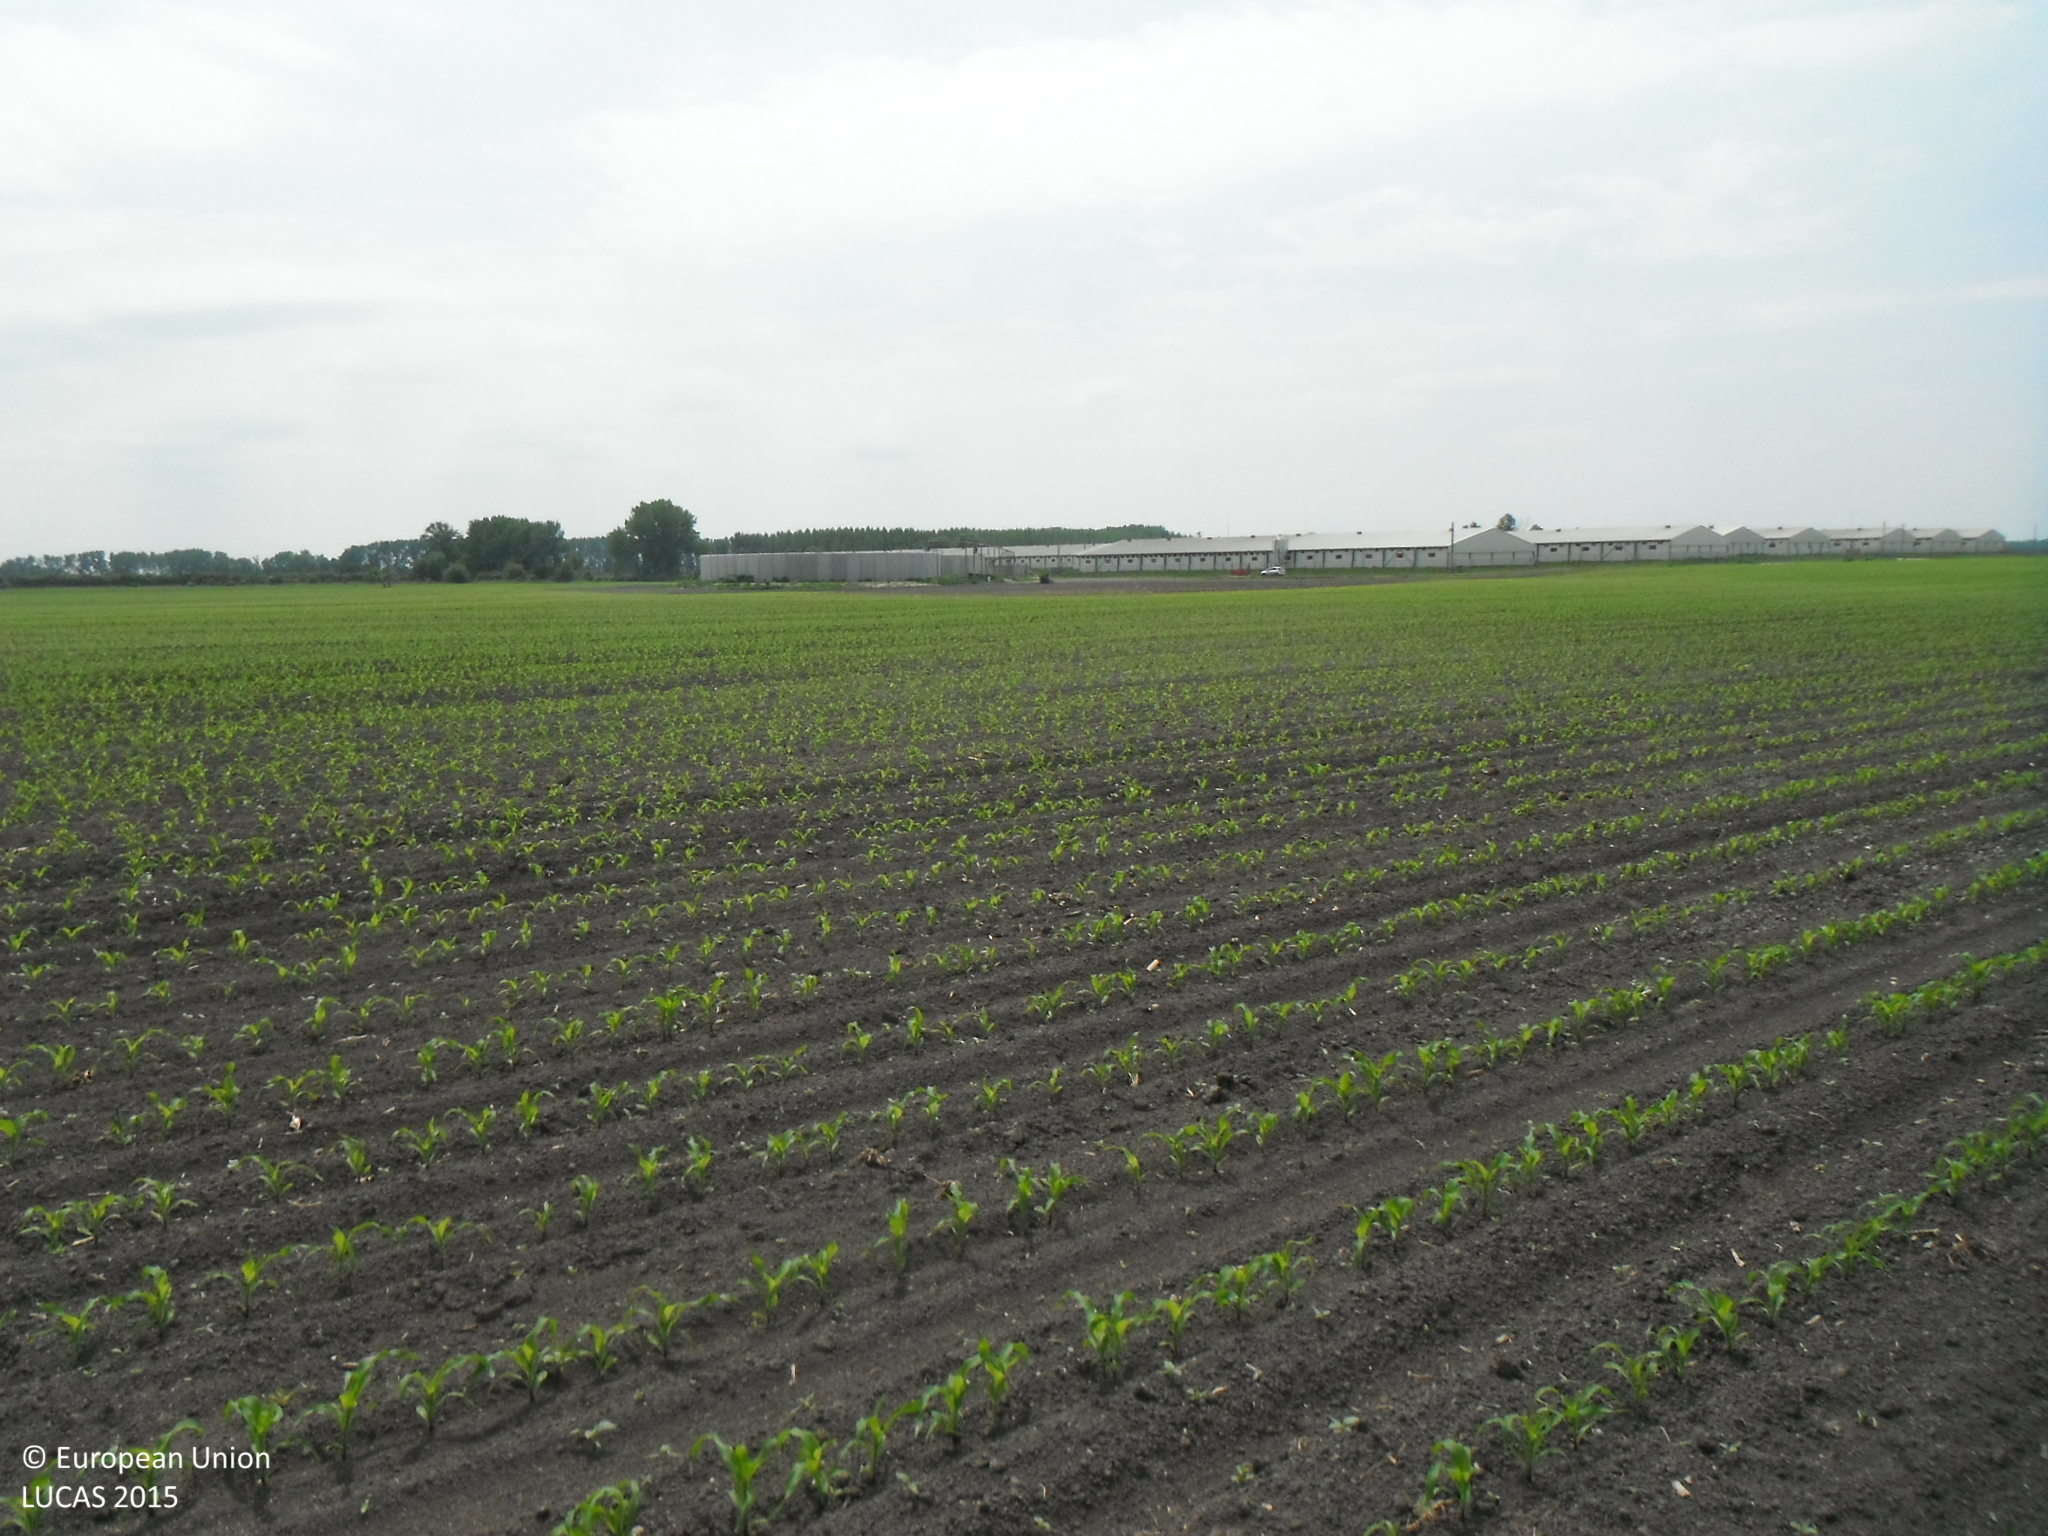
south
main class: Cropland
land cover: Maize
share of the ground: < 10 %
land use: Agriculture (excluding fallow land and kitchen gardens)
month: May
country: SK
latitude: 47.8978
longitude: 17.7285
